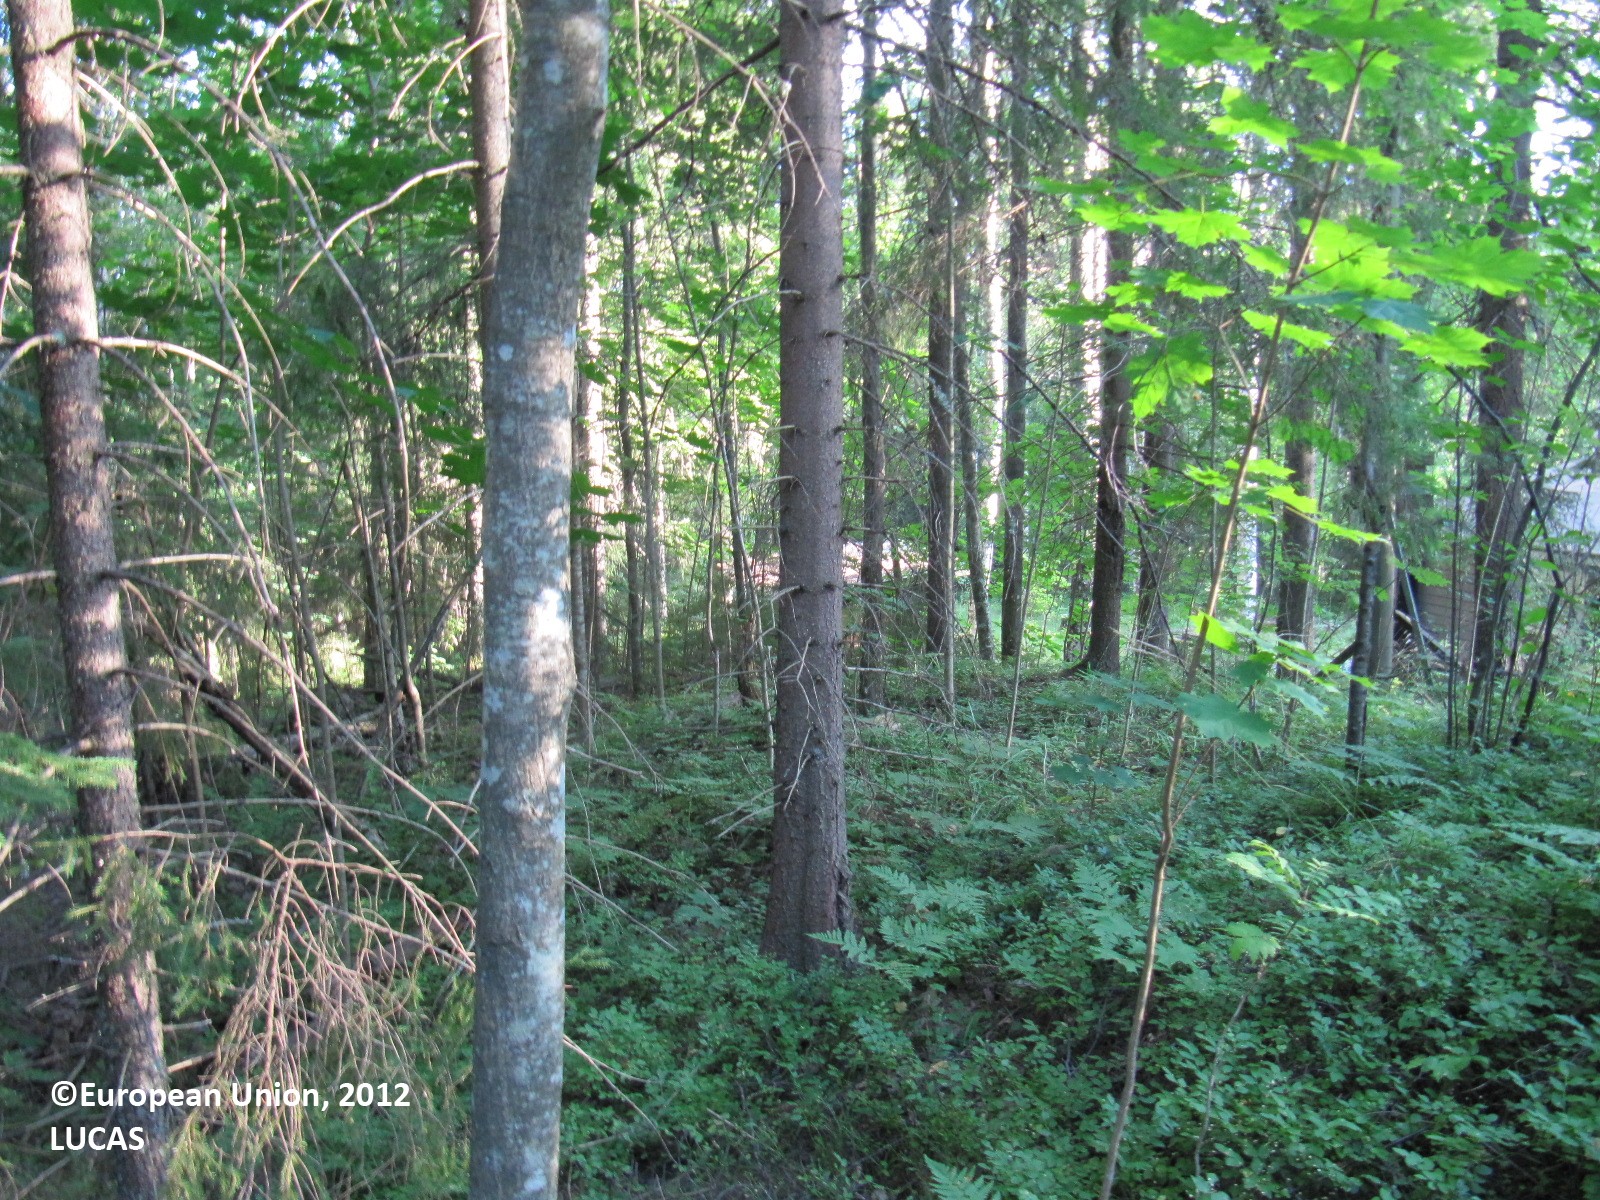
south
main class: Woodland
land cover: Spruce dominated mixed woodland
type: boreal forest
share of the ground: > 75 %
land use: Forestry
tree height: > 5 m
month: August
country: FI
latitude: 60.5426
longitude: 24.5261
